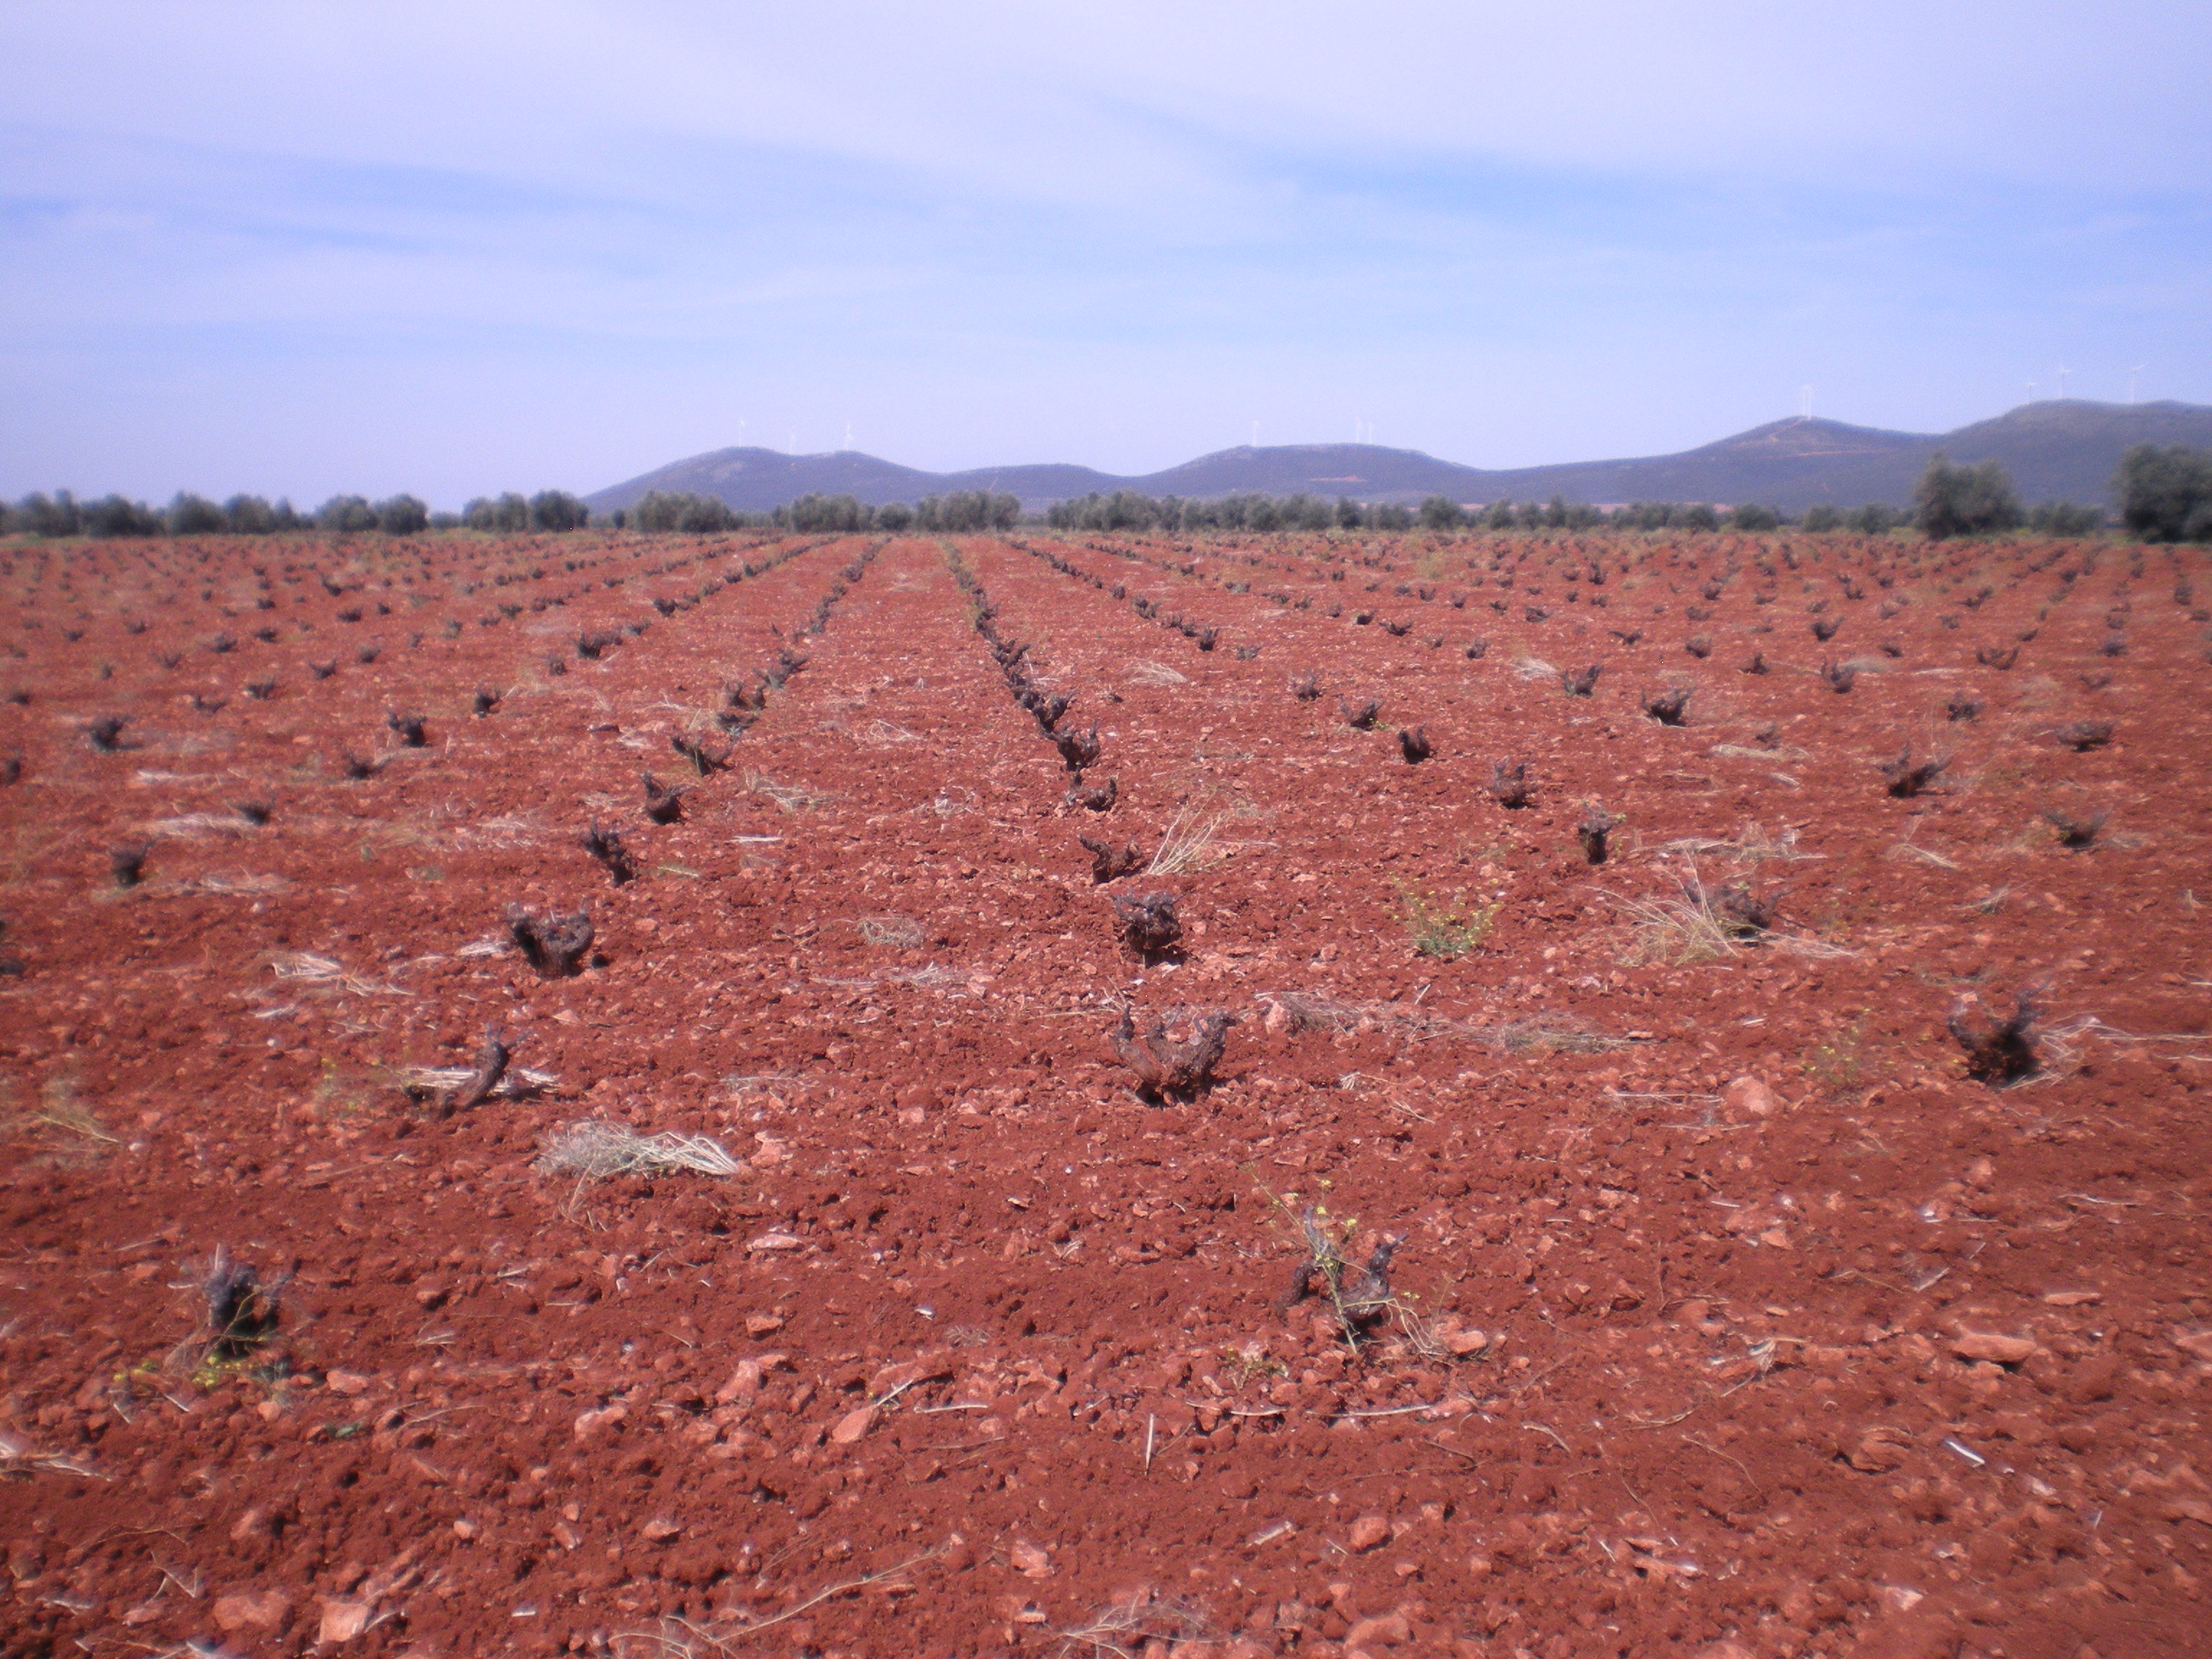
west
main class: Cropland
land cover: Vineyards
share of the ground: < 10 %
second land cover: Other bare soil
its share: > 75 %
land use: Agriculture (excluding fallow land and kitchen gardens)
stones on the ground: 10 - 25 %
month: April
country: ES
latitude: 38.8157
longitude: -3.2431
